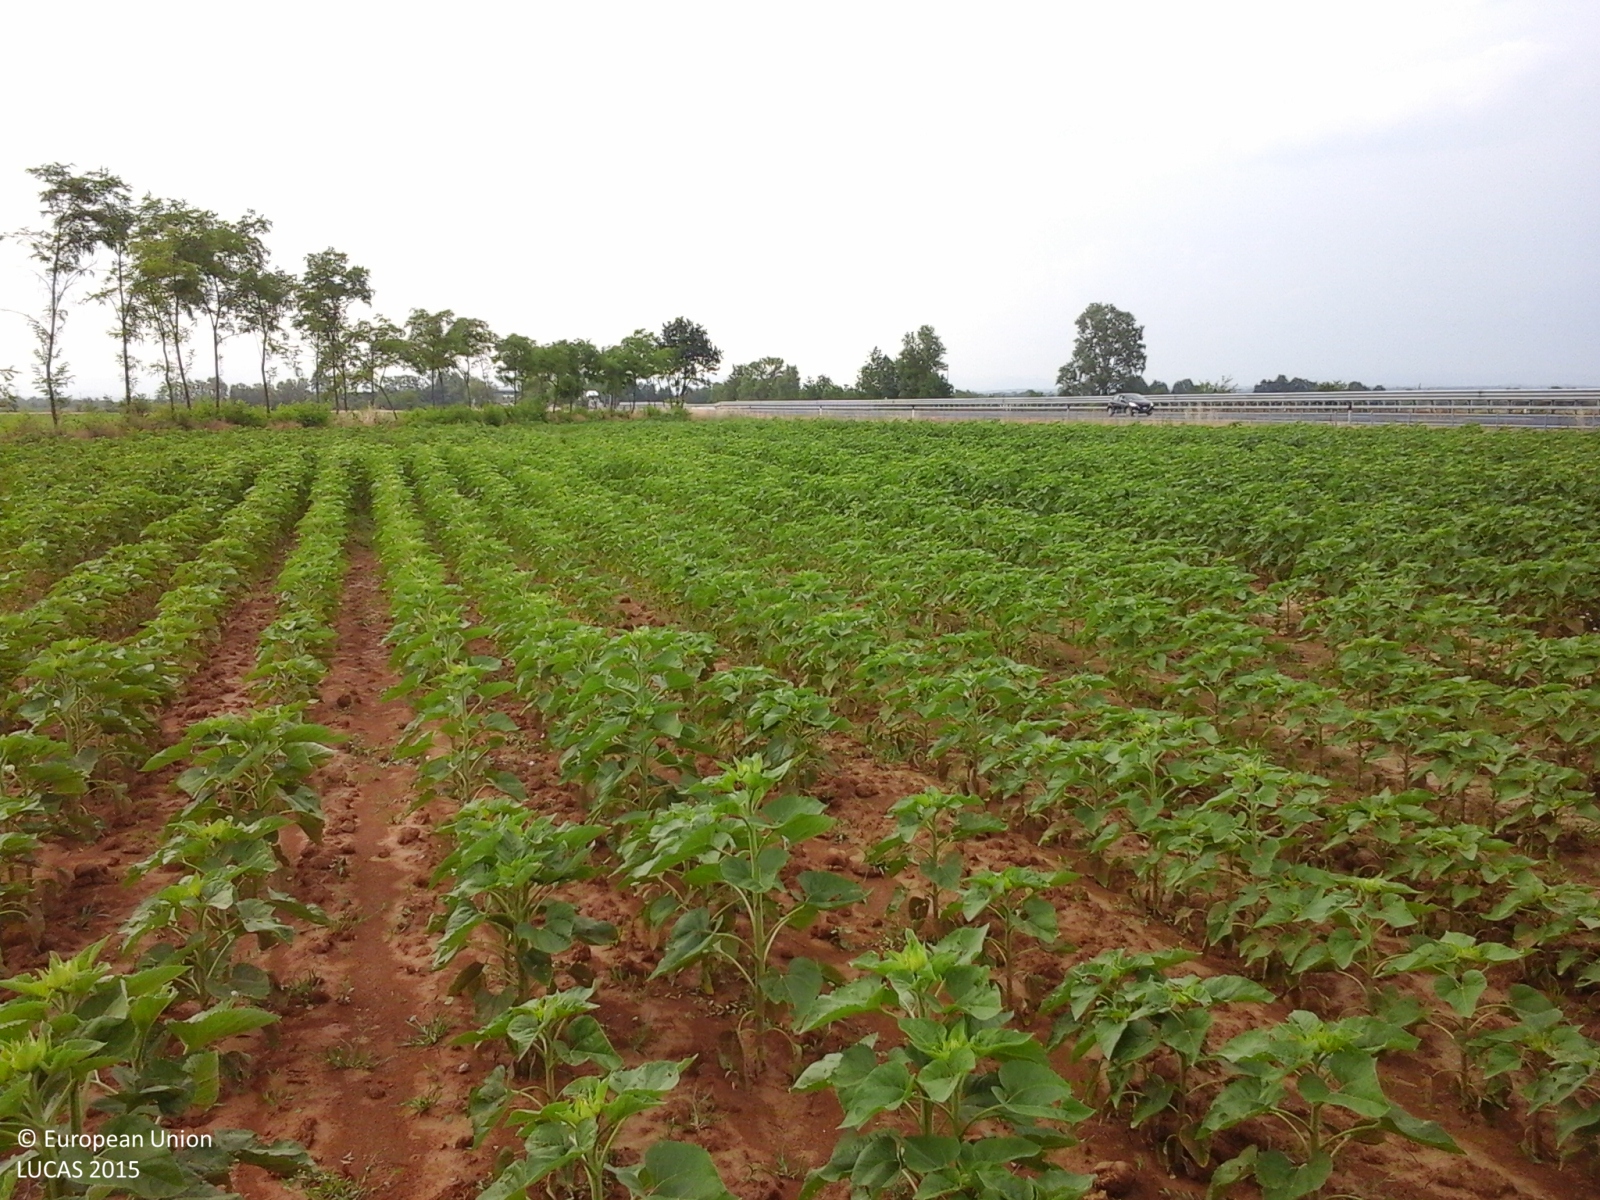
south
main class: Cropland
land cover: Sunflower
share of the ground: 50 - 75 %
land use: Agriculture (excluding fallow land and kitchen gardens)
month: June
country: IT
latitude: 44.8100
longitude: 8.5993
